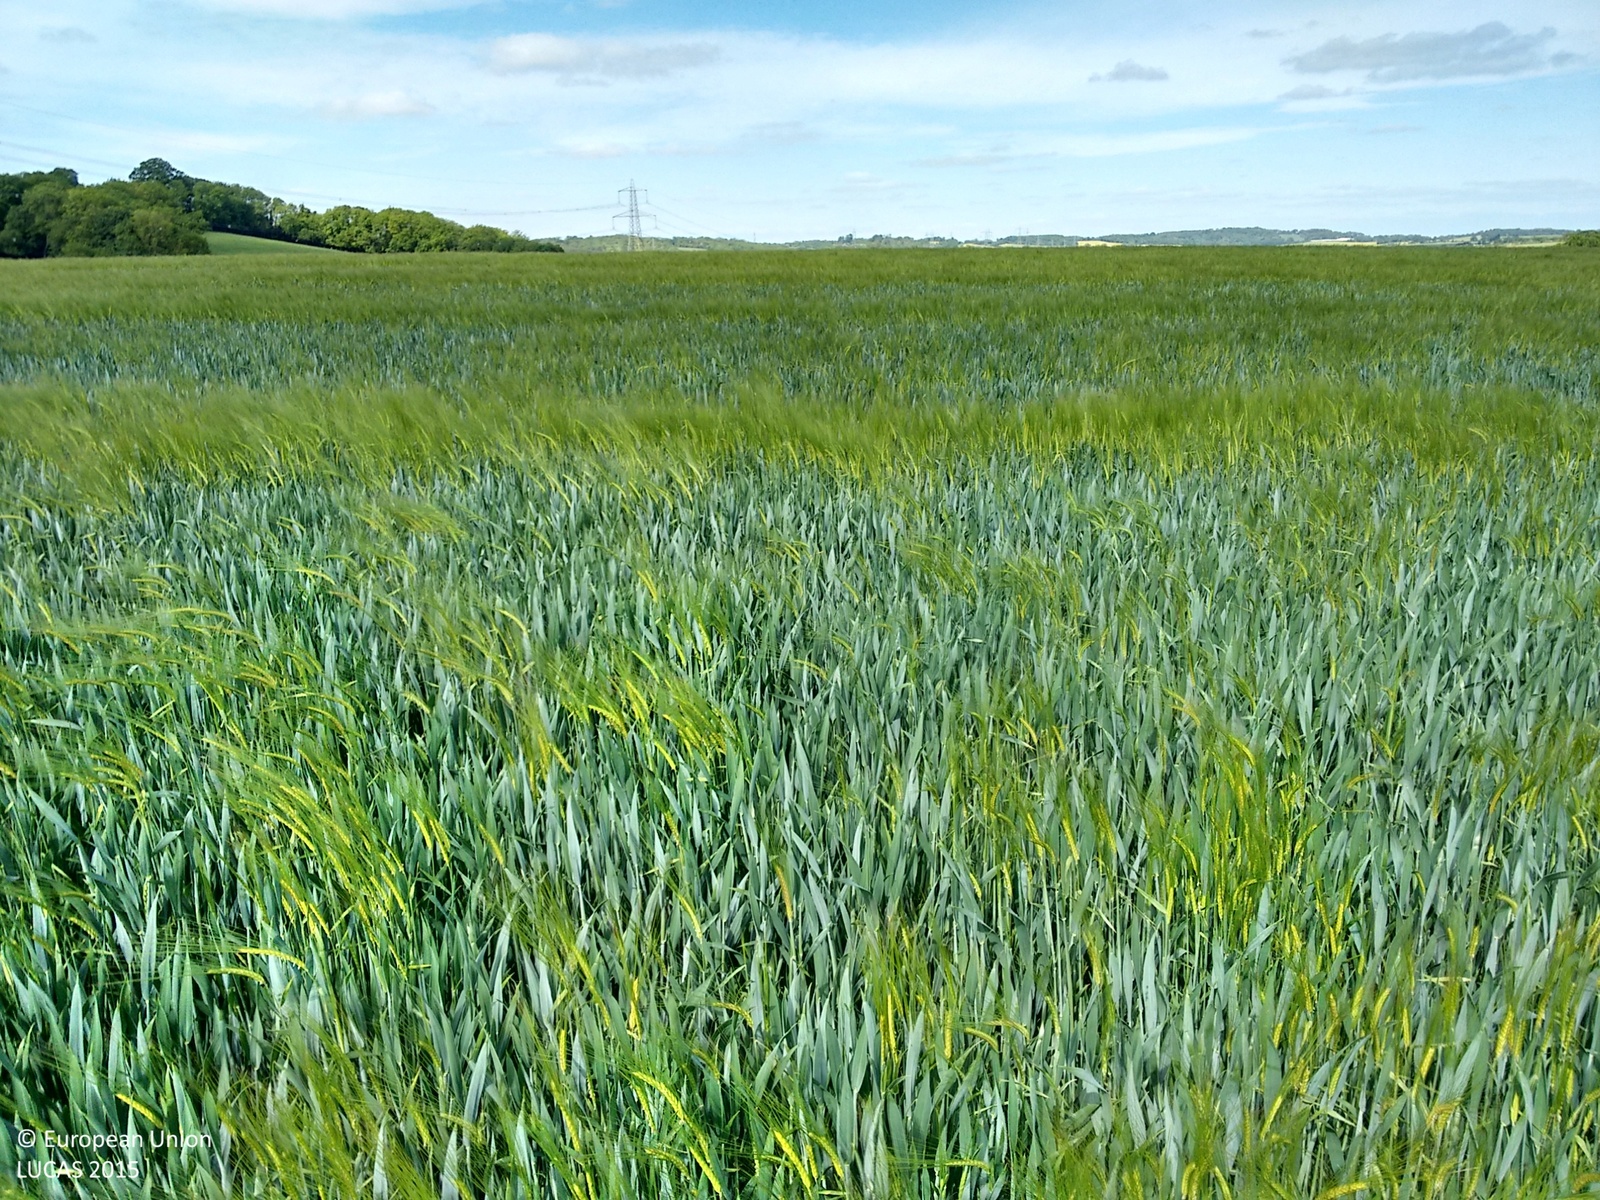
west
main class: Cropland
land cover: Common wheat
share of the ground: > 75 %
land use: Agriculture (excluding fallow land and kitchen gardens)
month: May
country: GB
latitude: 51.9292
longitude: -0.2886
